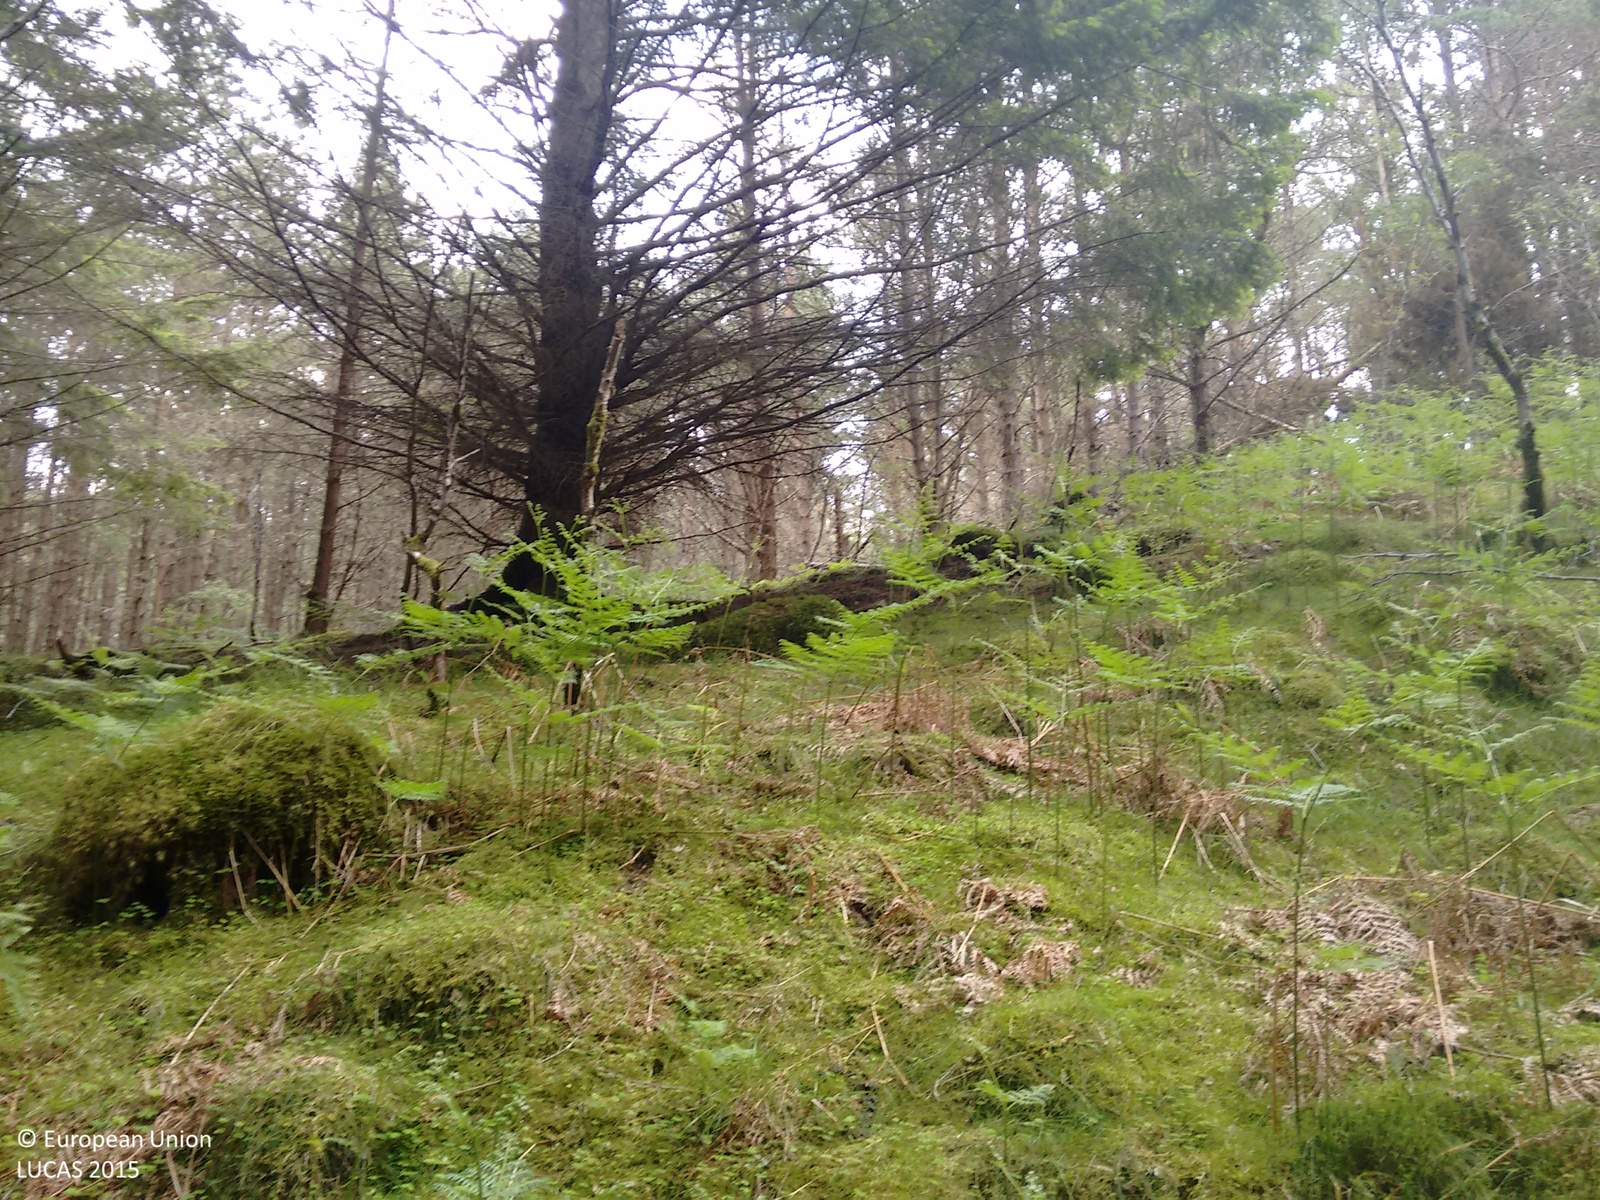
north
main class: Woodland
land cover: Spruce dominated coniferous woodland
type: exotic forest
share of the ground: > 75 %
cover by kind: coniferous forest trees 100 %
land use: Forestry
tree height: > 5 m
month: July
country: GB
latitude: 56.7146
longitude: -3.9873
